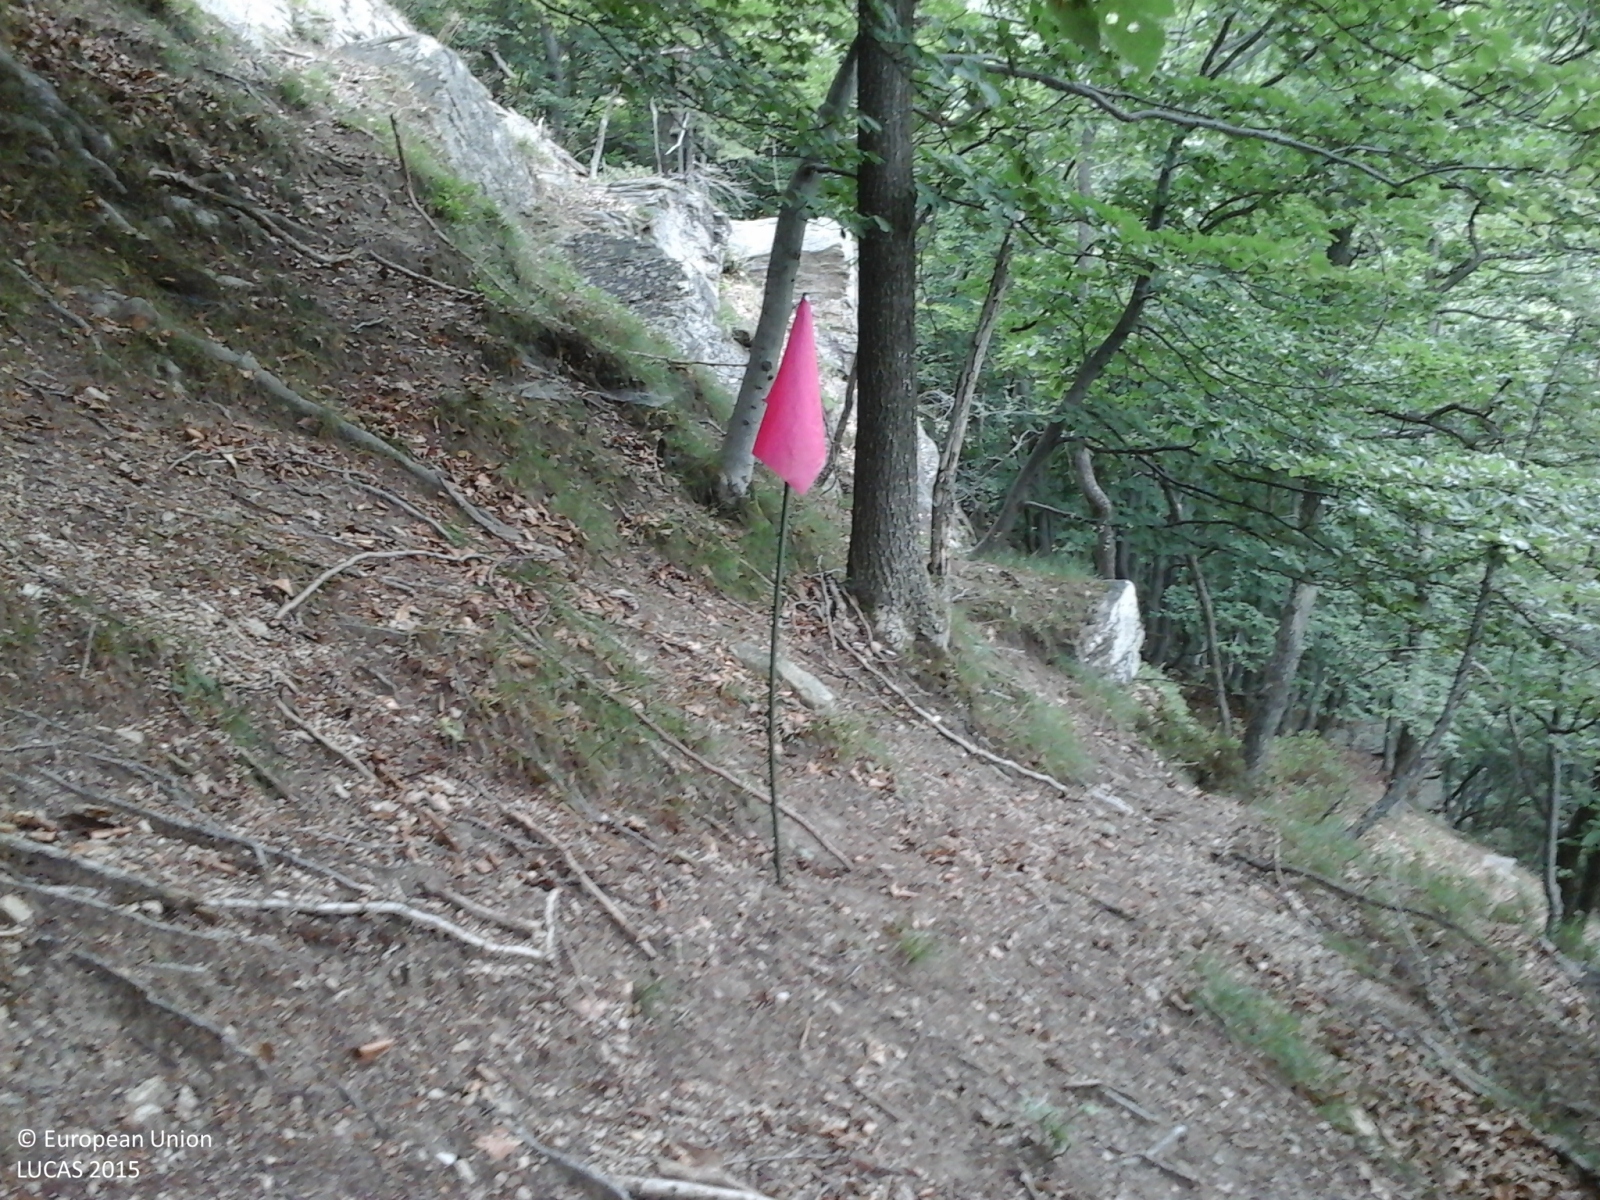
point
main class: Woodland
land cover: Broadleaved woodland
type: beech forest
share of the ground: > 75 %
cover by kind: broadleaved forest trees 100 %
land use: Semi-natural and natural areas not in use
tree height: > 5 m
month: July
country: IT
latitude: 44.9817
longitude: 7.2528
